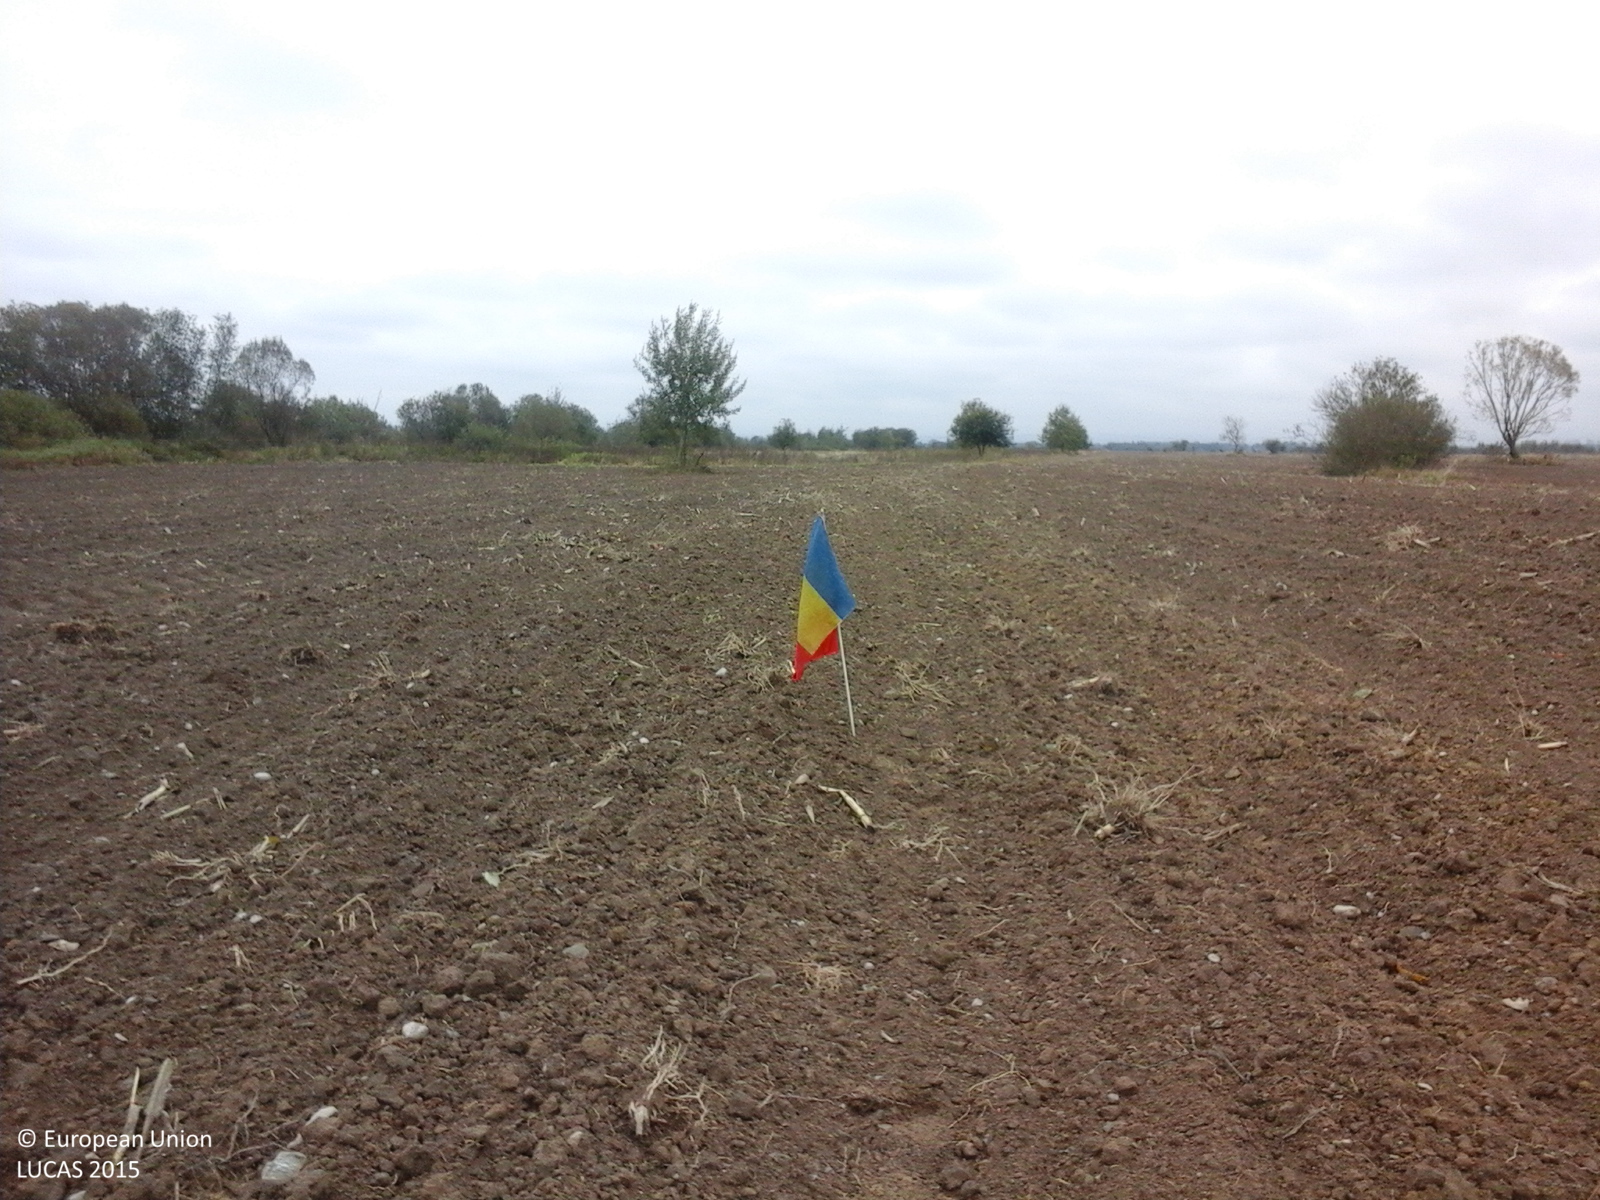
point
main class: Cropland
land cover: Maize
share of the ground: < 10 %
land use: Agriculture (excluding fallow land and kitchen gardens)
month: October
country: RO
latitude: 45.7913
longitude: 24.9228
